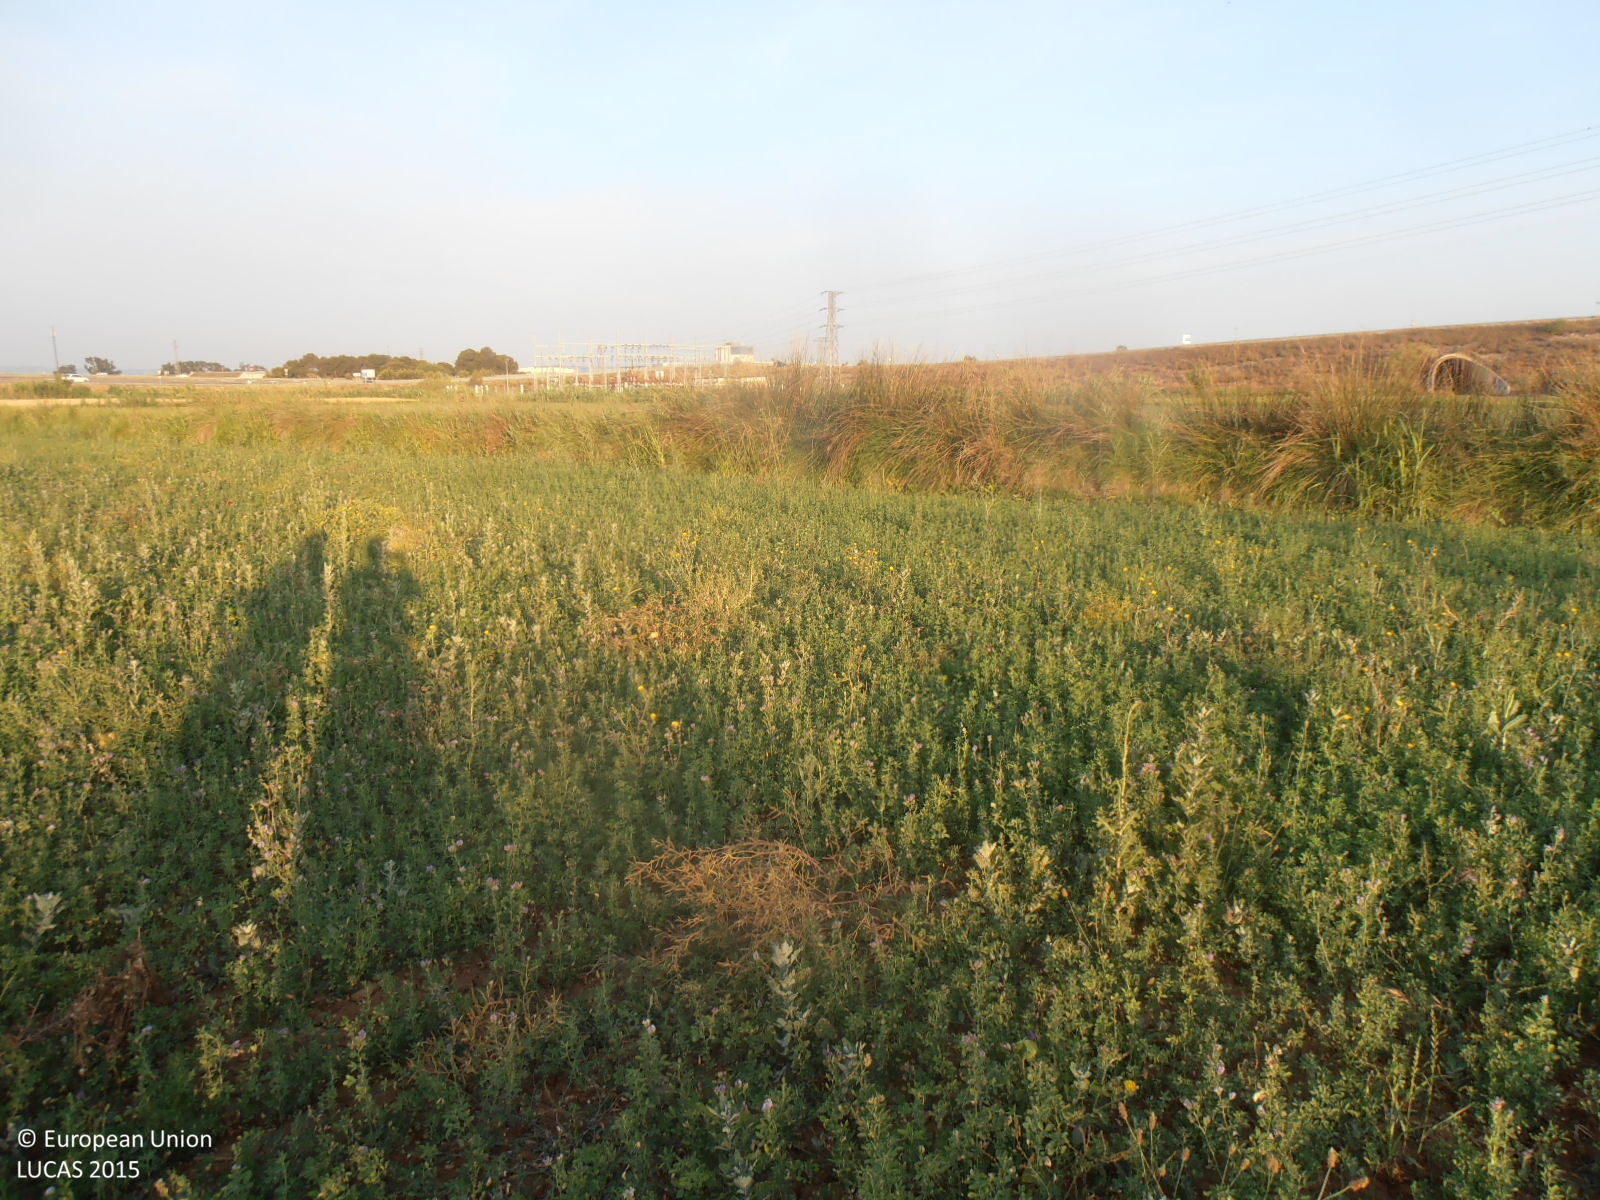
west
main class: Cropland
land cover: Lucerne
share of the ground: > 75 %
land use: Agriculture (excluding fallow land and kitchen gardens)
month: June
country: ES
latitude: 41.6922
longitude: -0.9686
